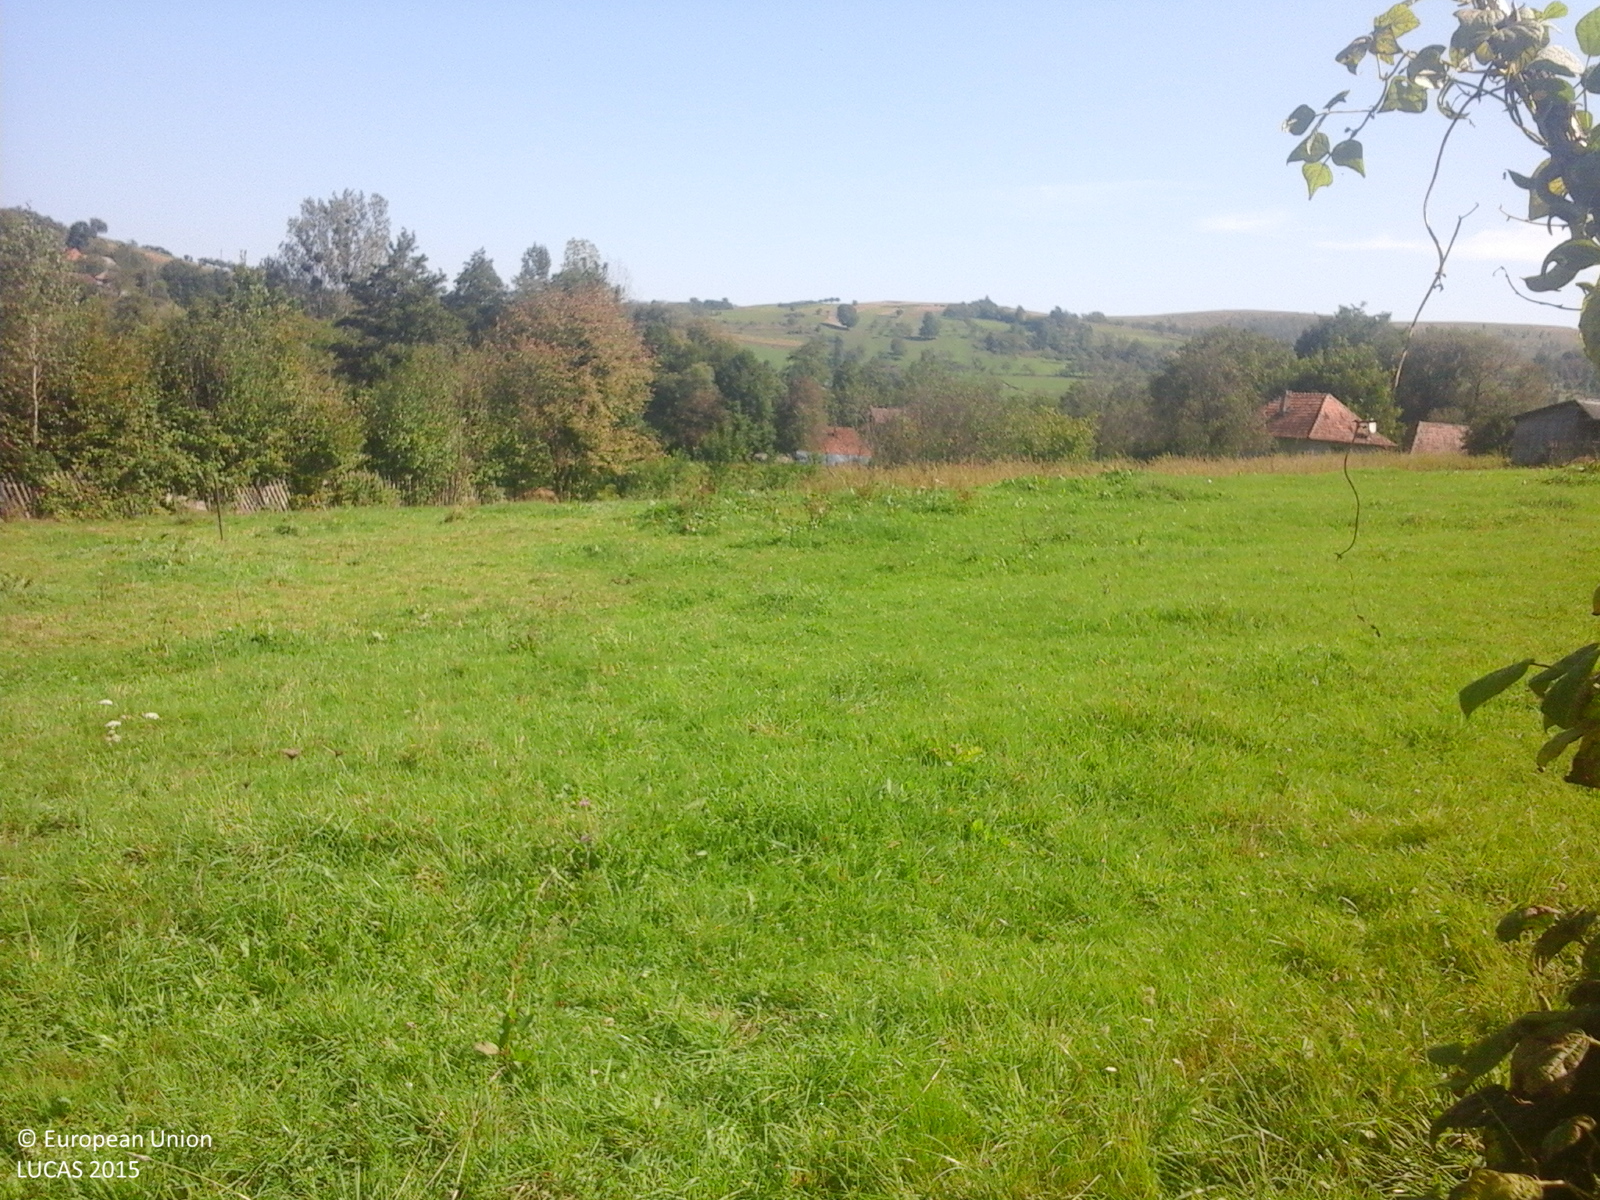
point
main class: Grassland
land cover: Grassland without tree/shrub cover
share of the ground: > 75 %
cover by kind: herbaceous plants 100 %
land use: Agriculture (excluding fallow land and kitchen gardens)
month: September
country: RO
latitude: 47.0829
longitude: 22.7159
